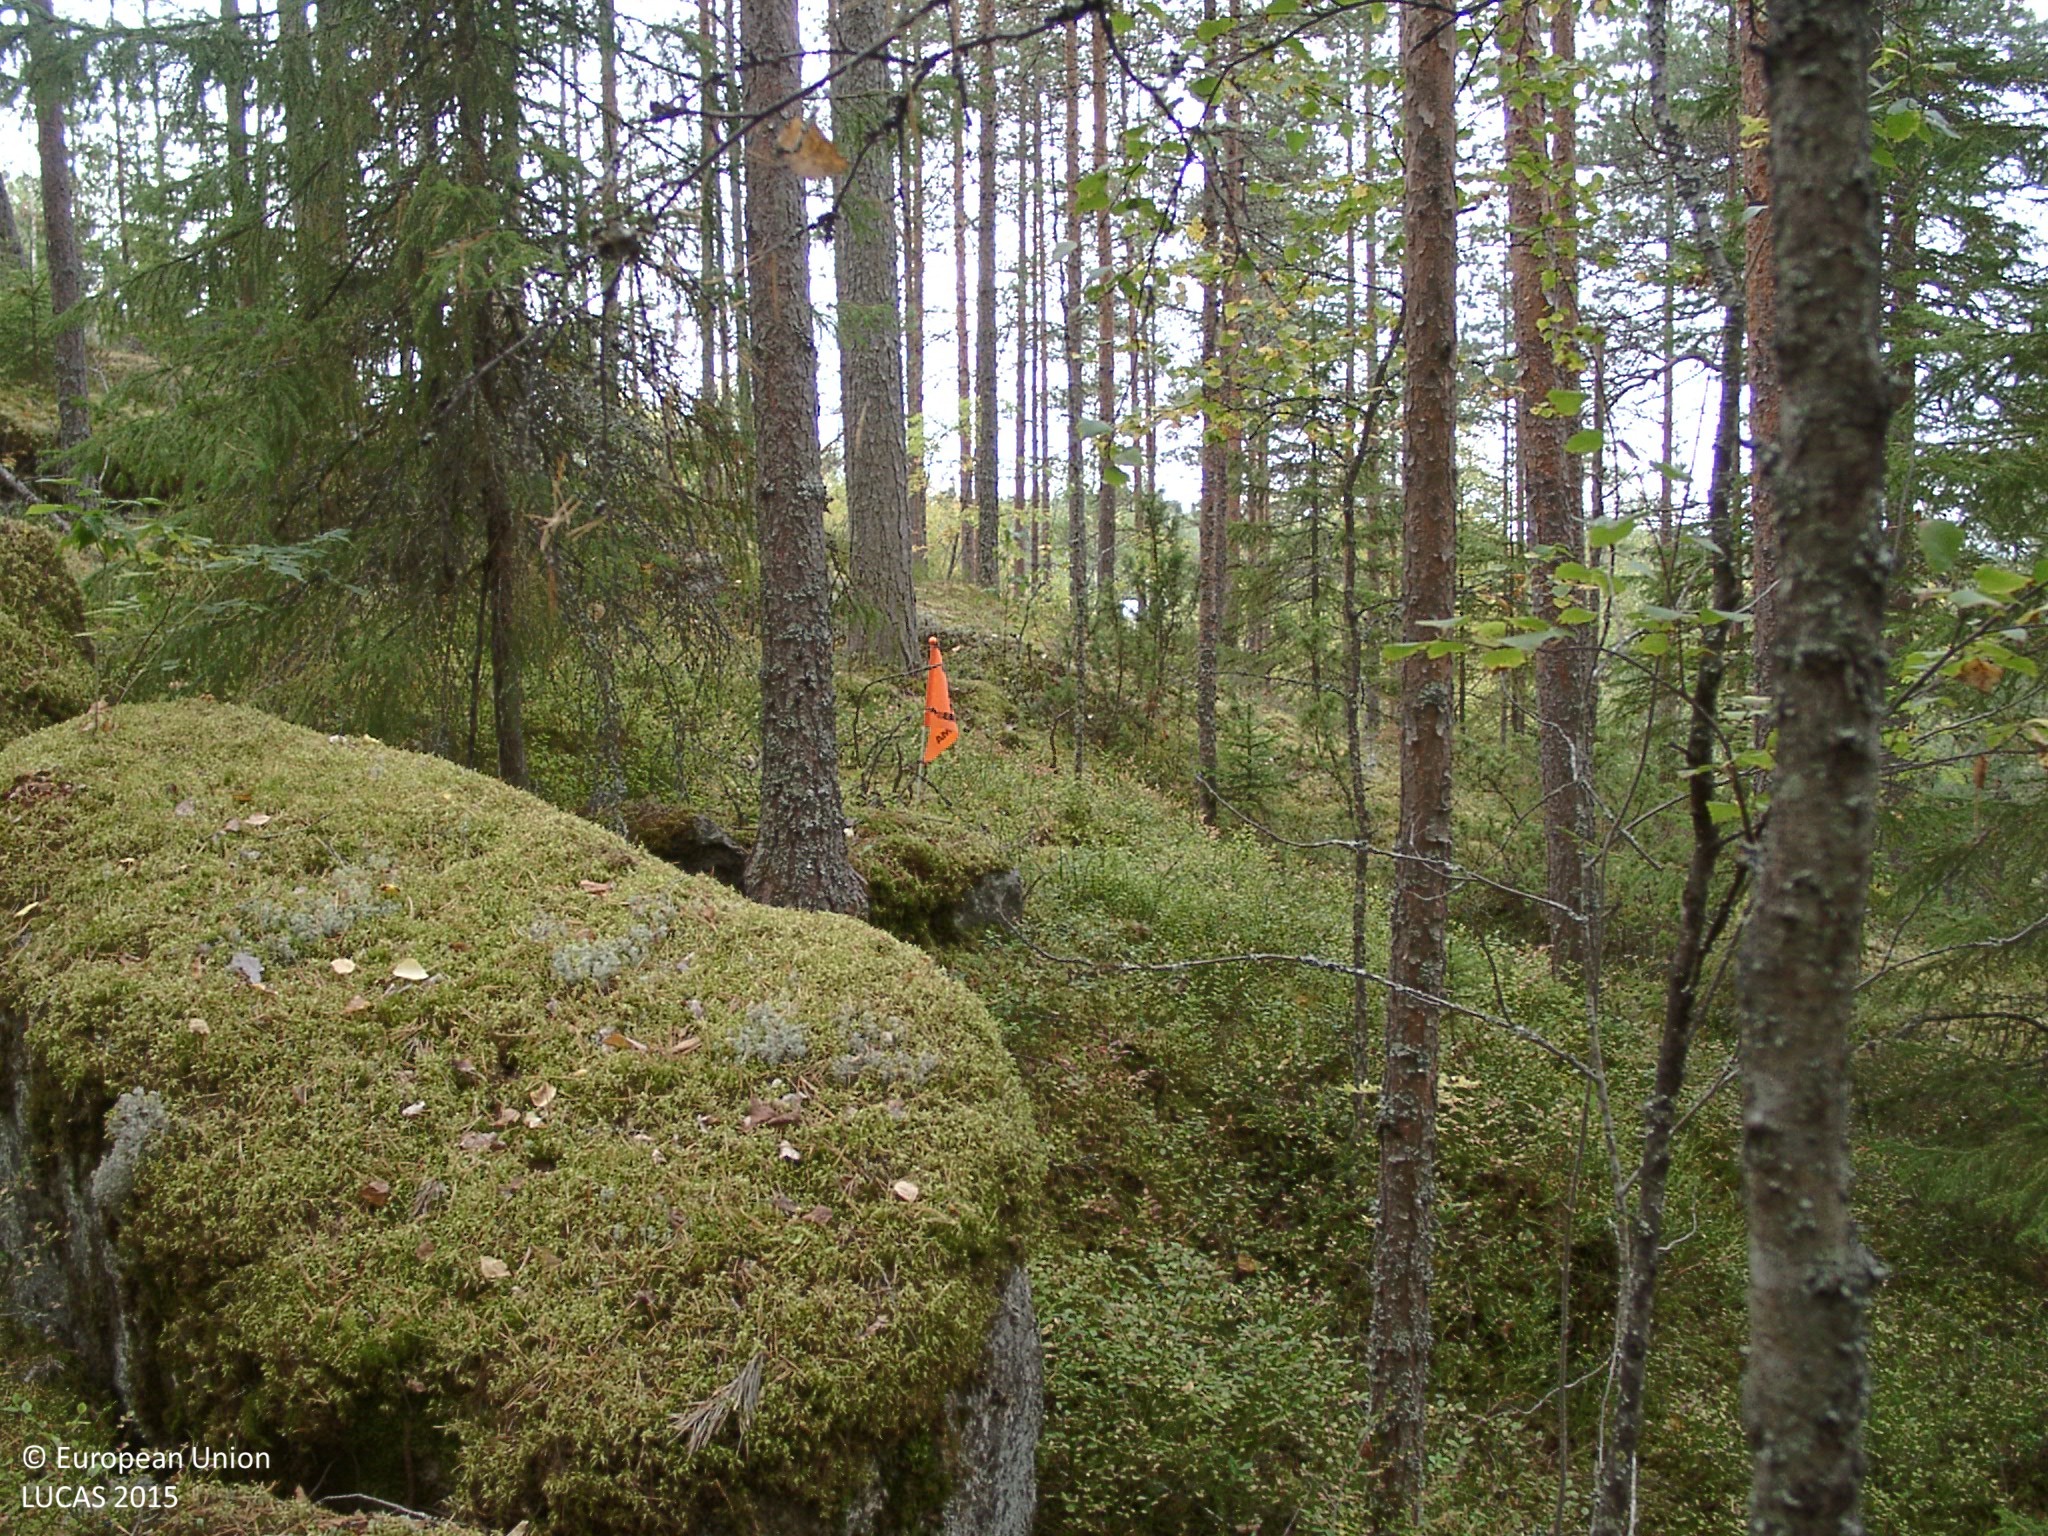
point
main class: Woodland
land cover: Pine dominated coniferous woodland
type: boreal forest
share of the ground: > 75 %
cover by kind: coniferous forest trees 80 %, lichens and mosses 10 %, broadleaved forest trees 5 %, shrubs 5 %
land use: Forestry
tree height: > 5 m
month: September
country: FI
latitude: 62.5581
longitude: 25.8553
